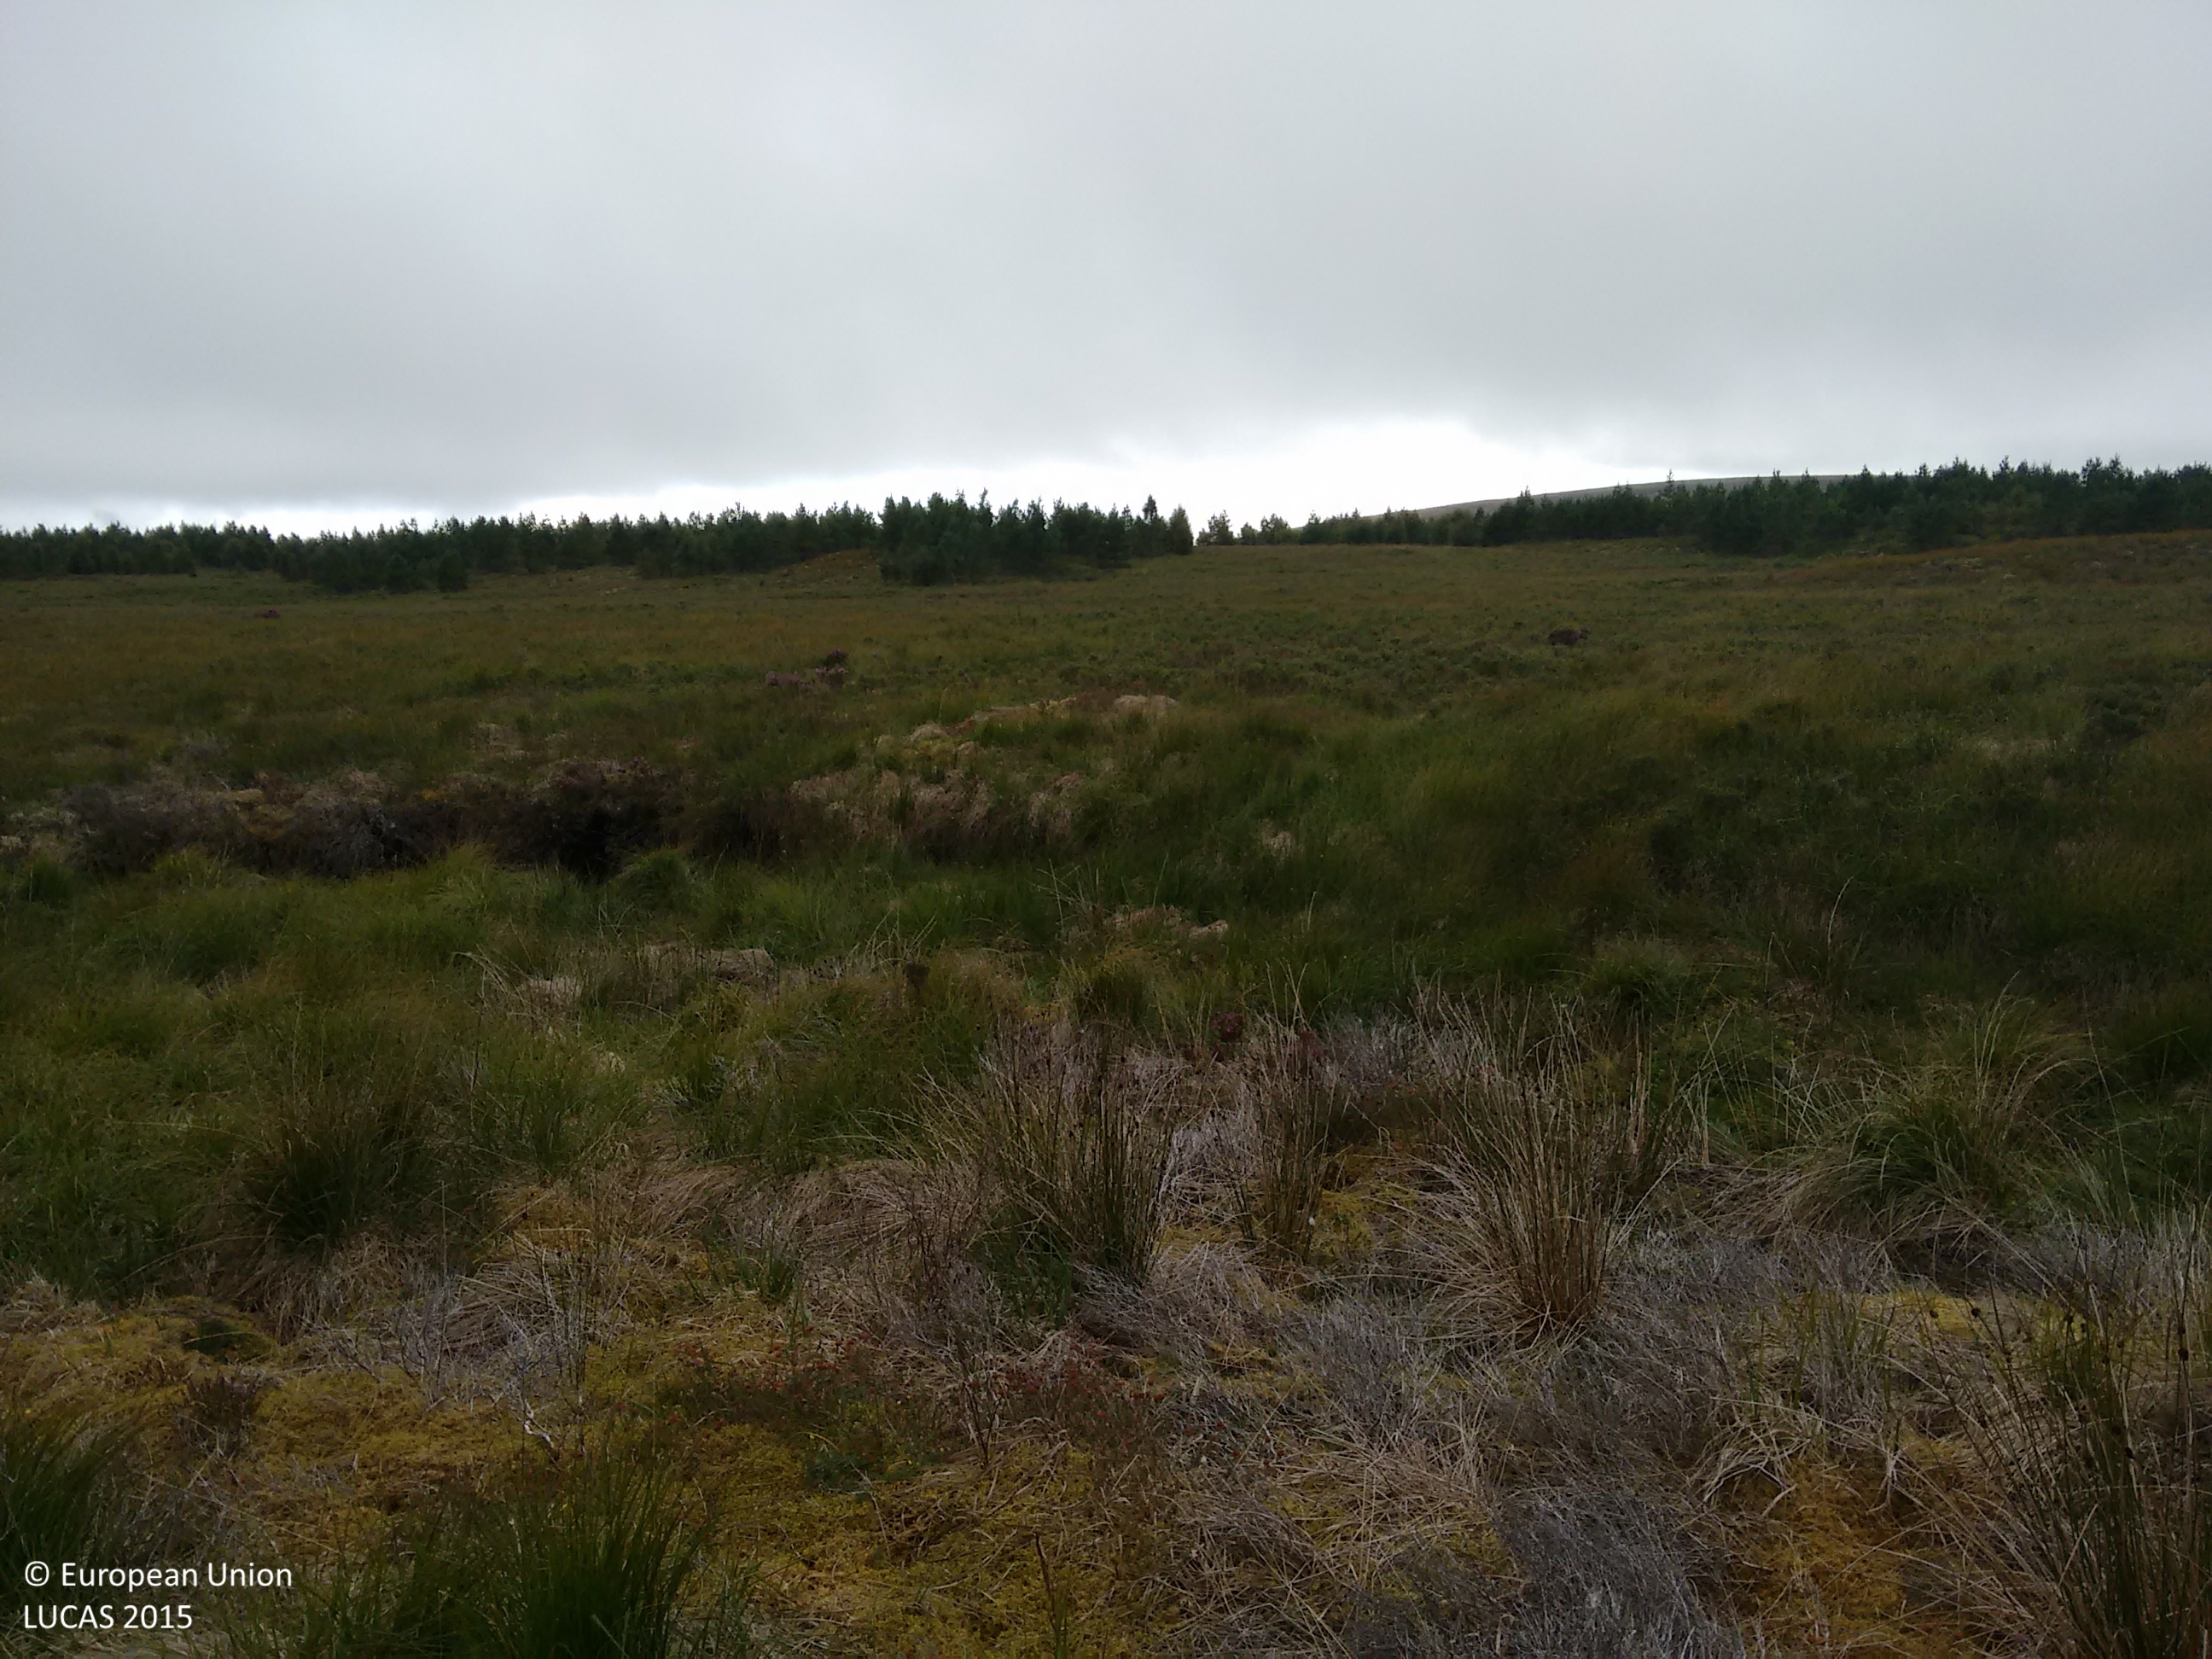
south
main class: Shrubland
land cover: Shrubland without tree cover
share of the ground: > 75 %
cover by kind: shrubs 40 %, herbaceous plants 20 %, lichens and mosses 20 %
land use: Forestry
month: September
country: GB
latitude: 58.0749
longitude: -4.1007
